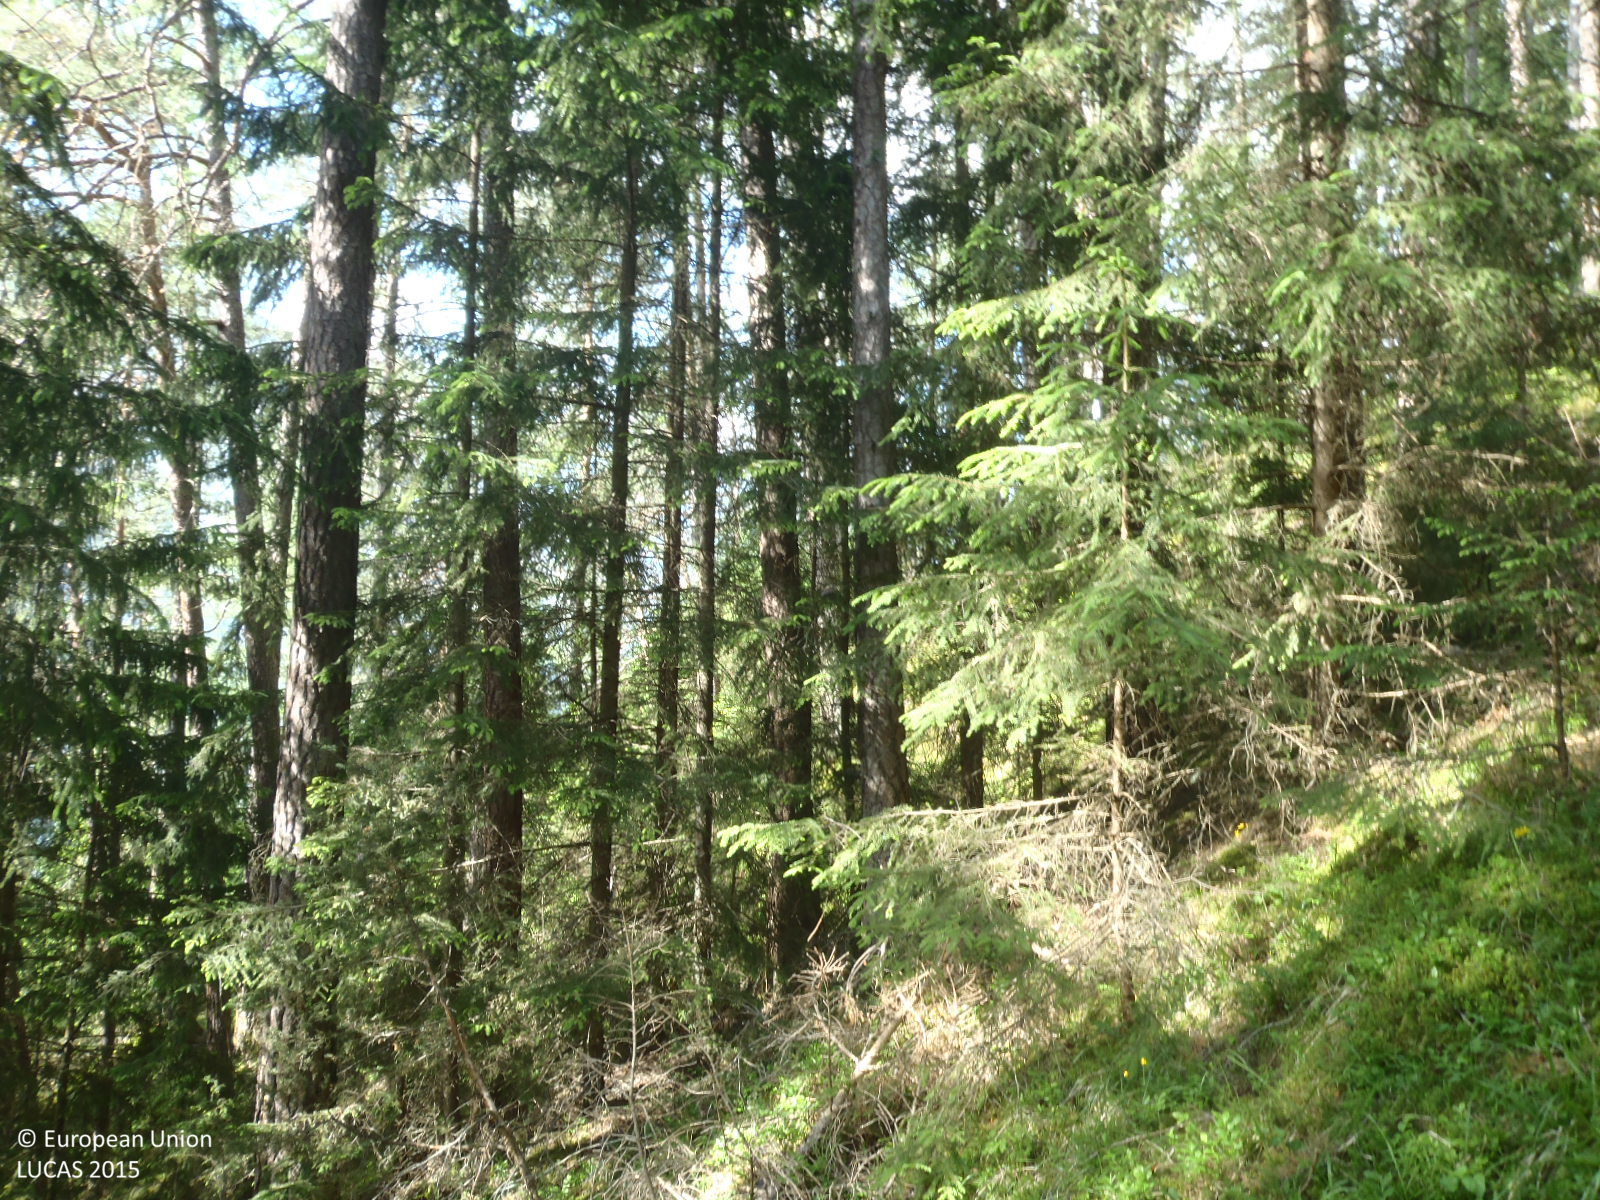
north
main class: Woodland
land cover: Pine dominated coniferous woodland
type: alpine coniferous forest
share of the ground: > 75 %
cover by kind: coniferous forest trees 85 %, herbaceous plants 10 %, lichens and mosses 5 %
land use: Forestry
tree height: > 5 m
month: June
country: AT
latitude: 47.2124
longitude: 10.8310
